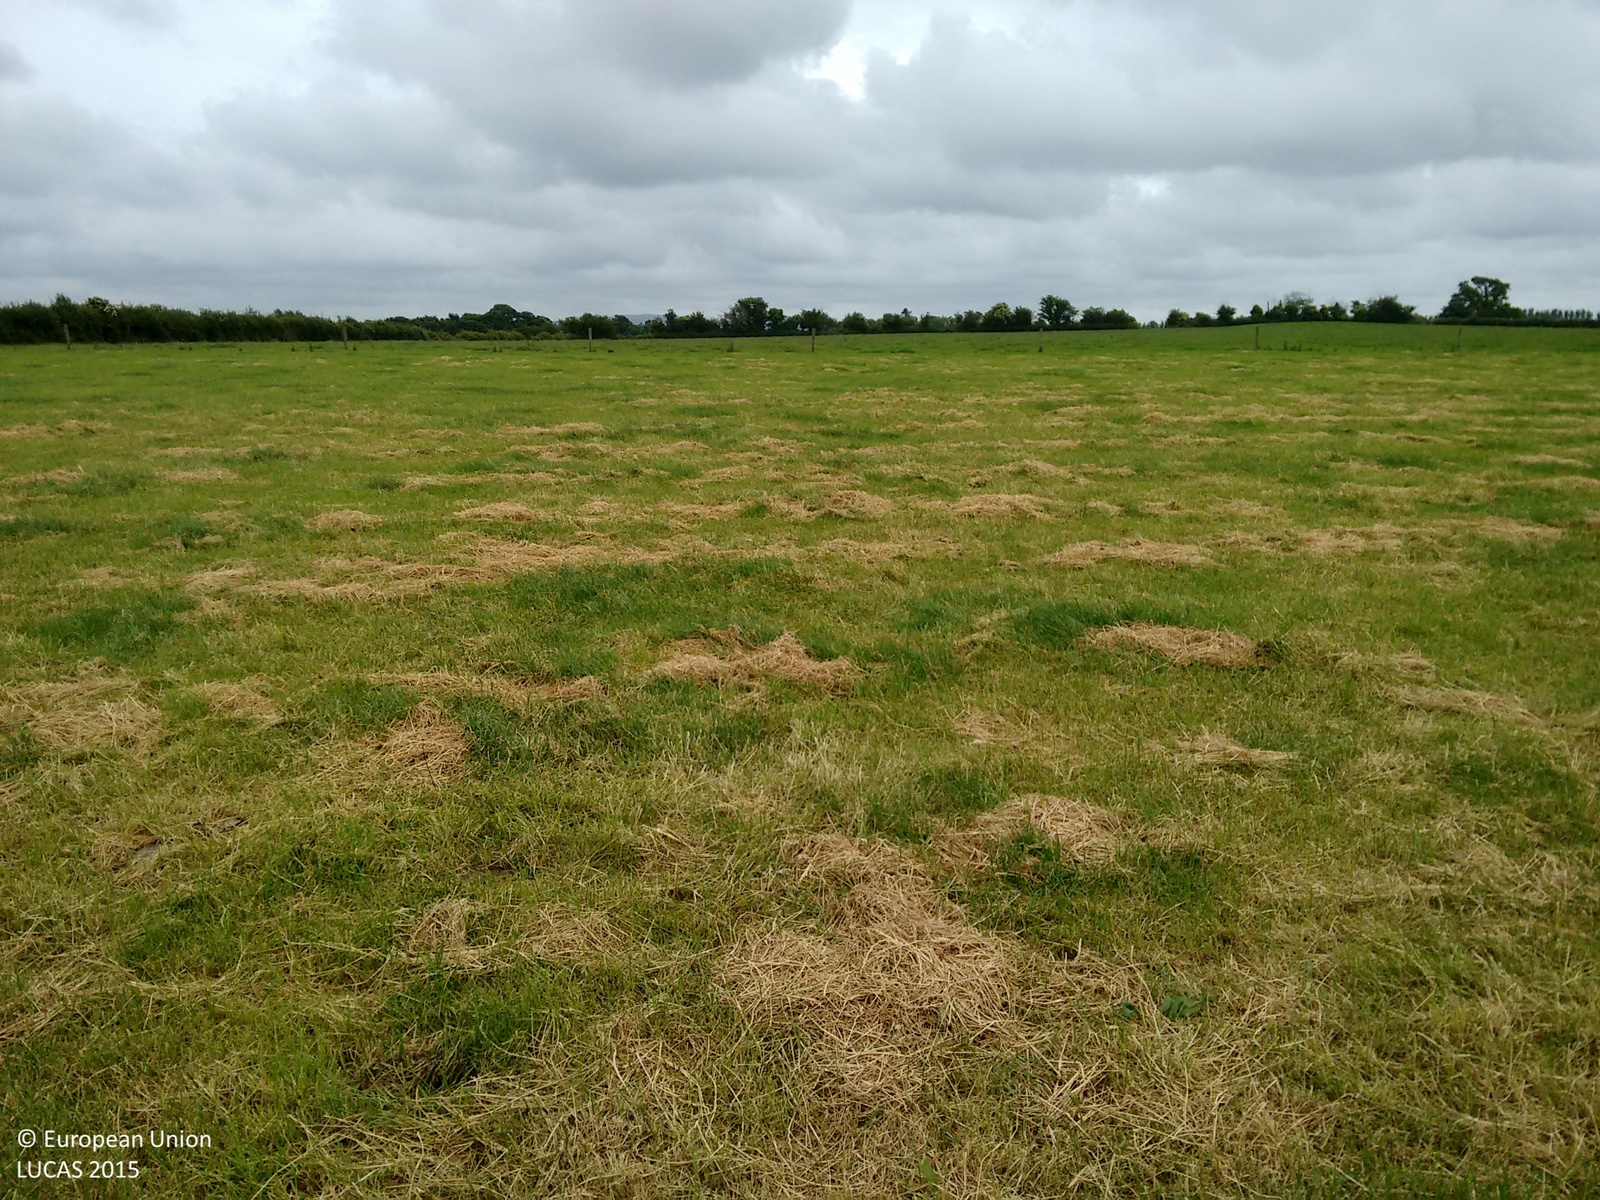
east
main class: Grassland
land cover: Grassland without tree/shrub cover
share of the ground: > 75 %
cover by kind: herbaceous plants 100 %
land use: Agriculture (excluding fallow land and kitchen gardens)
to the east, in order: Grassland without tree/shrub cover; Fences; Grassland without tree/shrub cover
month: June
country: IE
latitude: 52.3653
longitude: -7.4120
